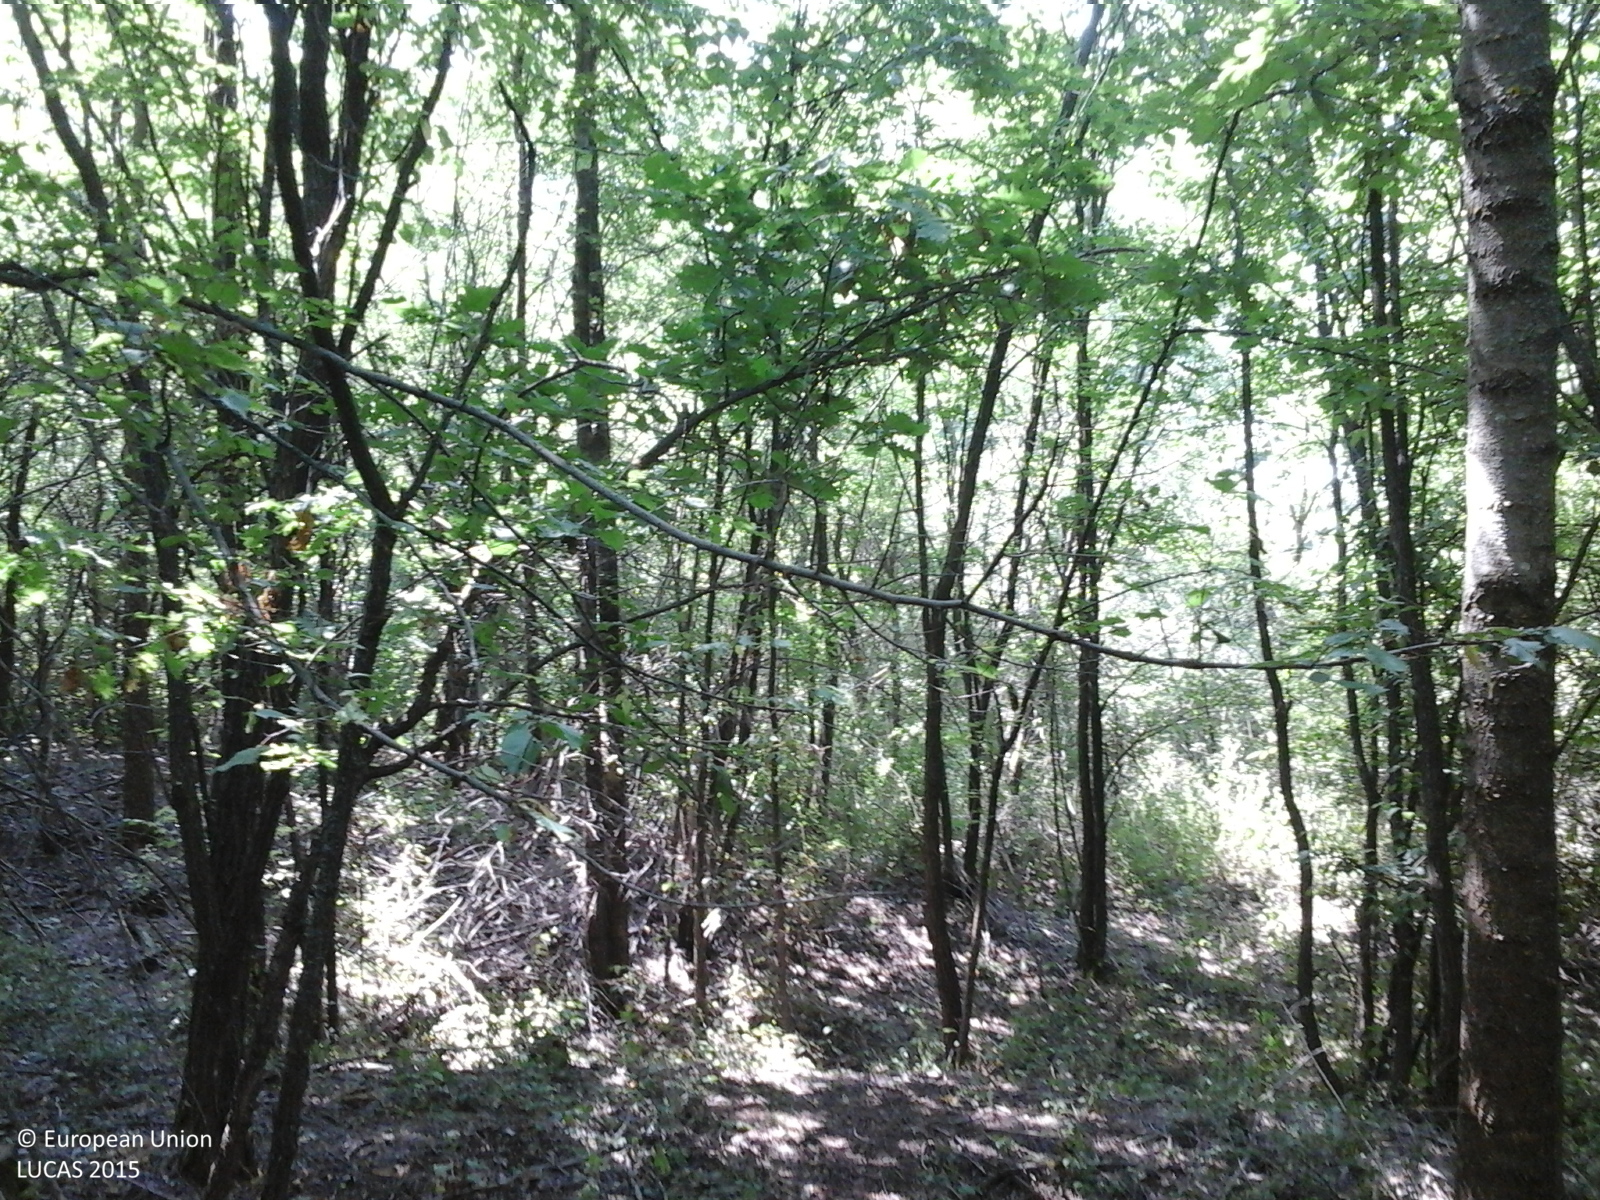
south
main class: Woodland
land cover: Broadleaved woodland
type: non-riverine alder, birch or aspen forest
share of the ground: > 75 %
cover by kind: broadleaved forest trees 100 %
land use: Forestry
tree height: > 5 m
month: July
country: RO
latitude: 44.6811
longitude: 24.6214
